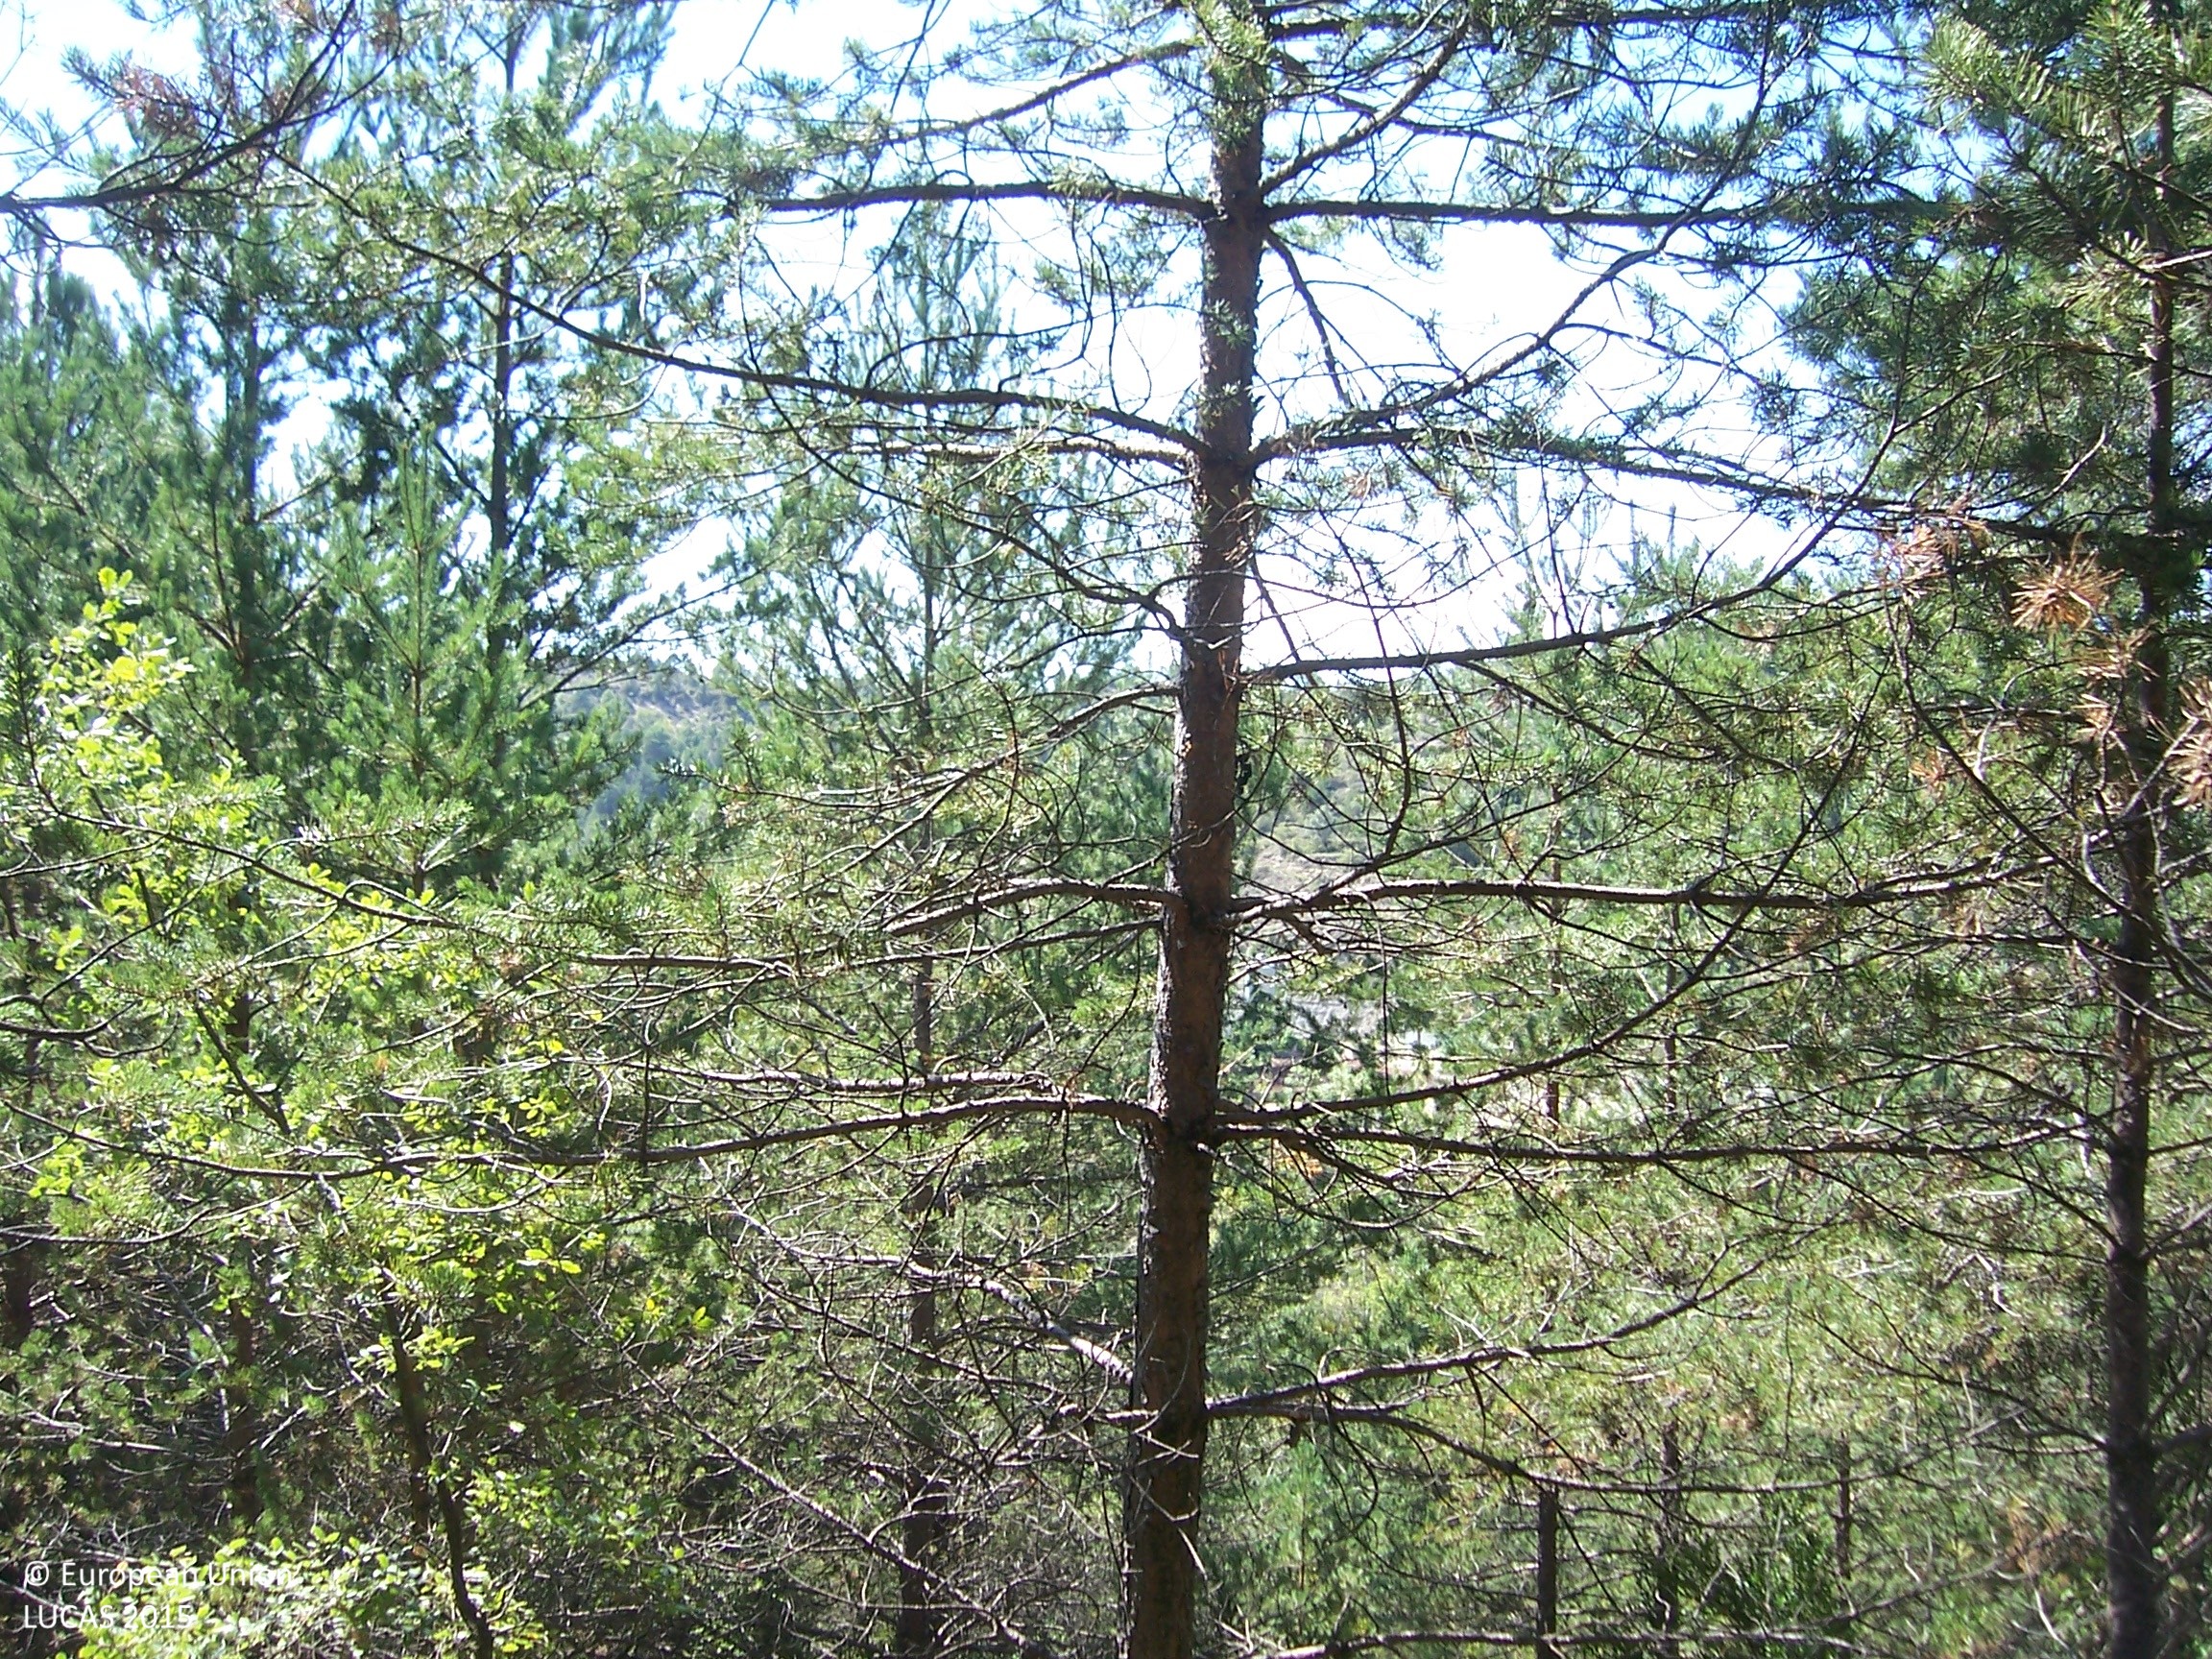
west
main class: Woodland
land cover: Pine dominated coniferous woodland
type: coniferous forest of the mediterranean region
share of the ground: > 75 %
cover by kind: coniferous forest trees 95 %, shrubs 5 %
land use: Forestry
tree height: > 5 m
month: August
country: ES
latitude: 42.3336
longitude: 0.3078
